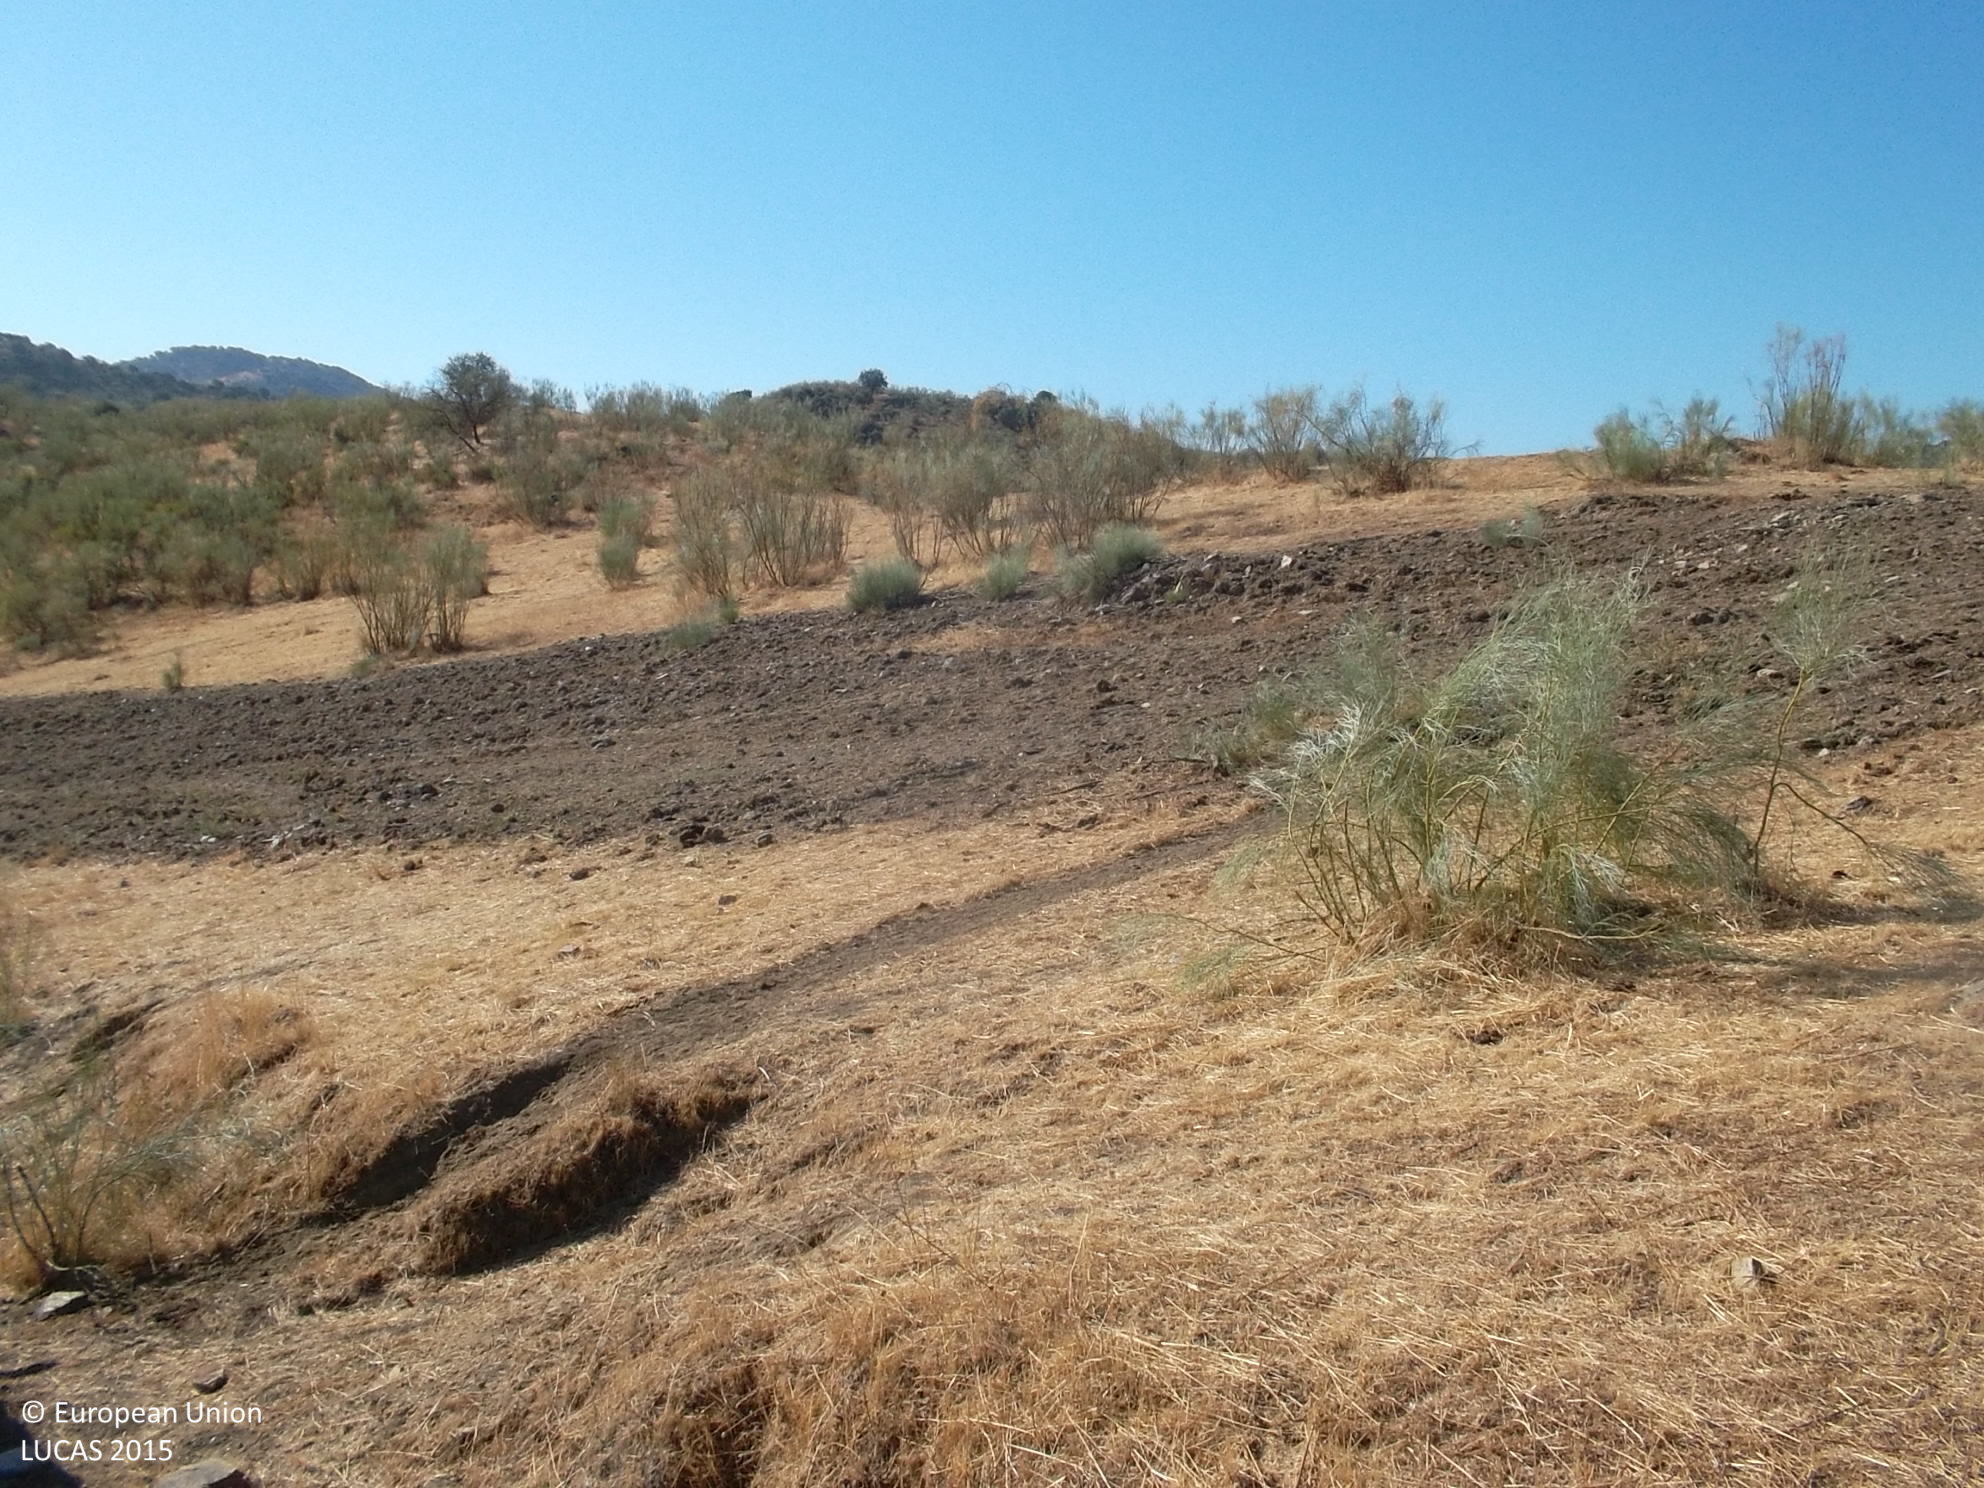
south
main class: Shrubland
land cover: Shrubland without tree cover
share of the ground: > 75 %
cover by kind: shrubs 50 %, herbaceous plants 50 %
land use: Agriculture (excluding fallow land and kitchen gardens)
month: August
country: ES
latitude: 38.2662
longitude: -6.7292
